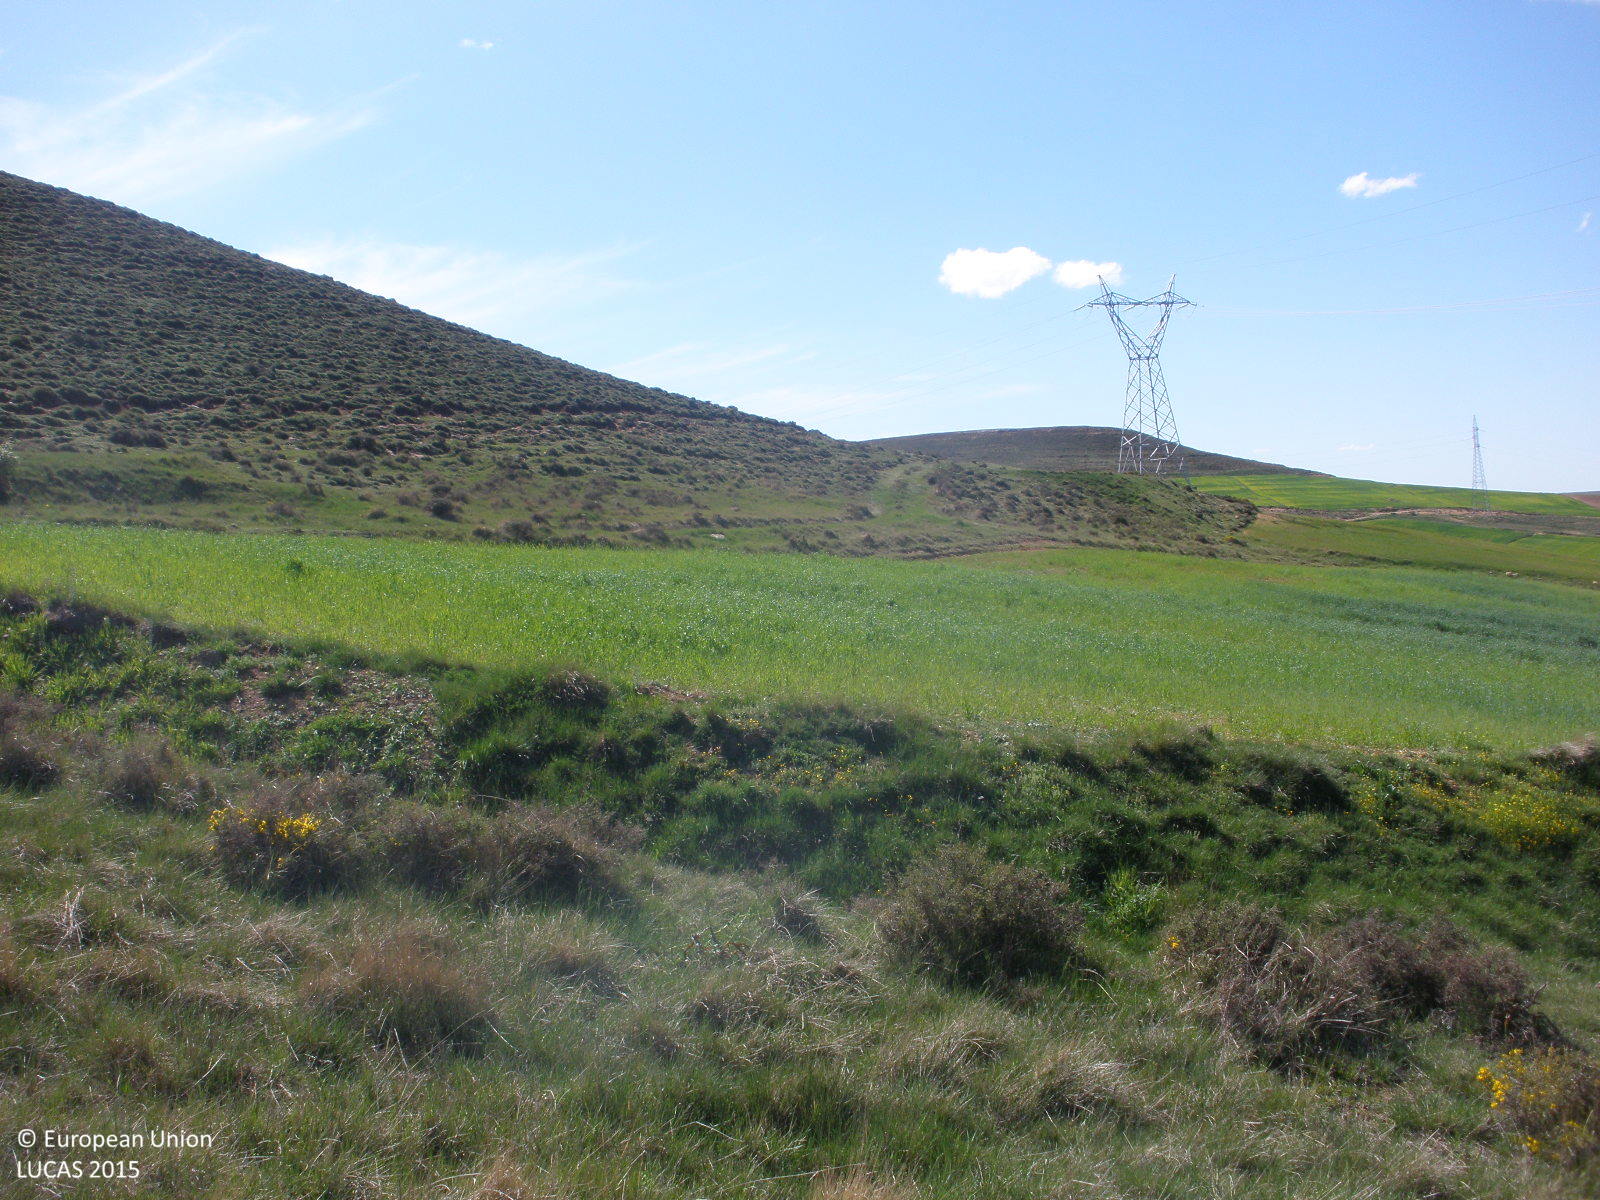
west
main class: Grassland
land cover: Grassland without tree/shrub cover
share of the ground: > 75 %
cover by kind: herbaceous plants 100 %
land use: Semi-natural and natural areas not in use
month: May
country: ES
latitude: 40.7167
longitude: -0.8920
